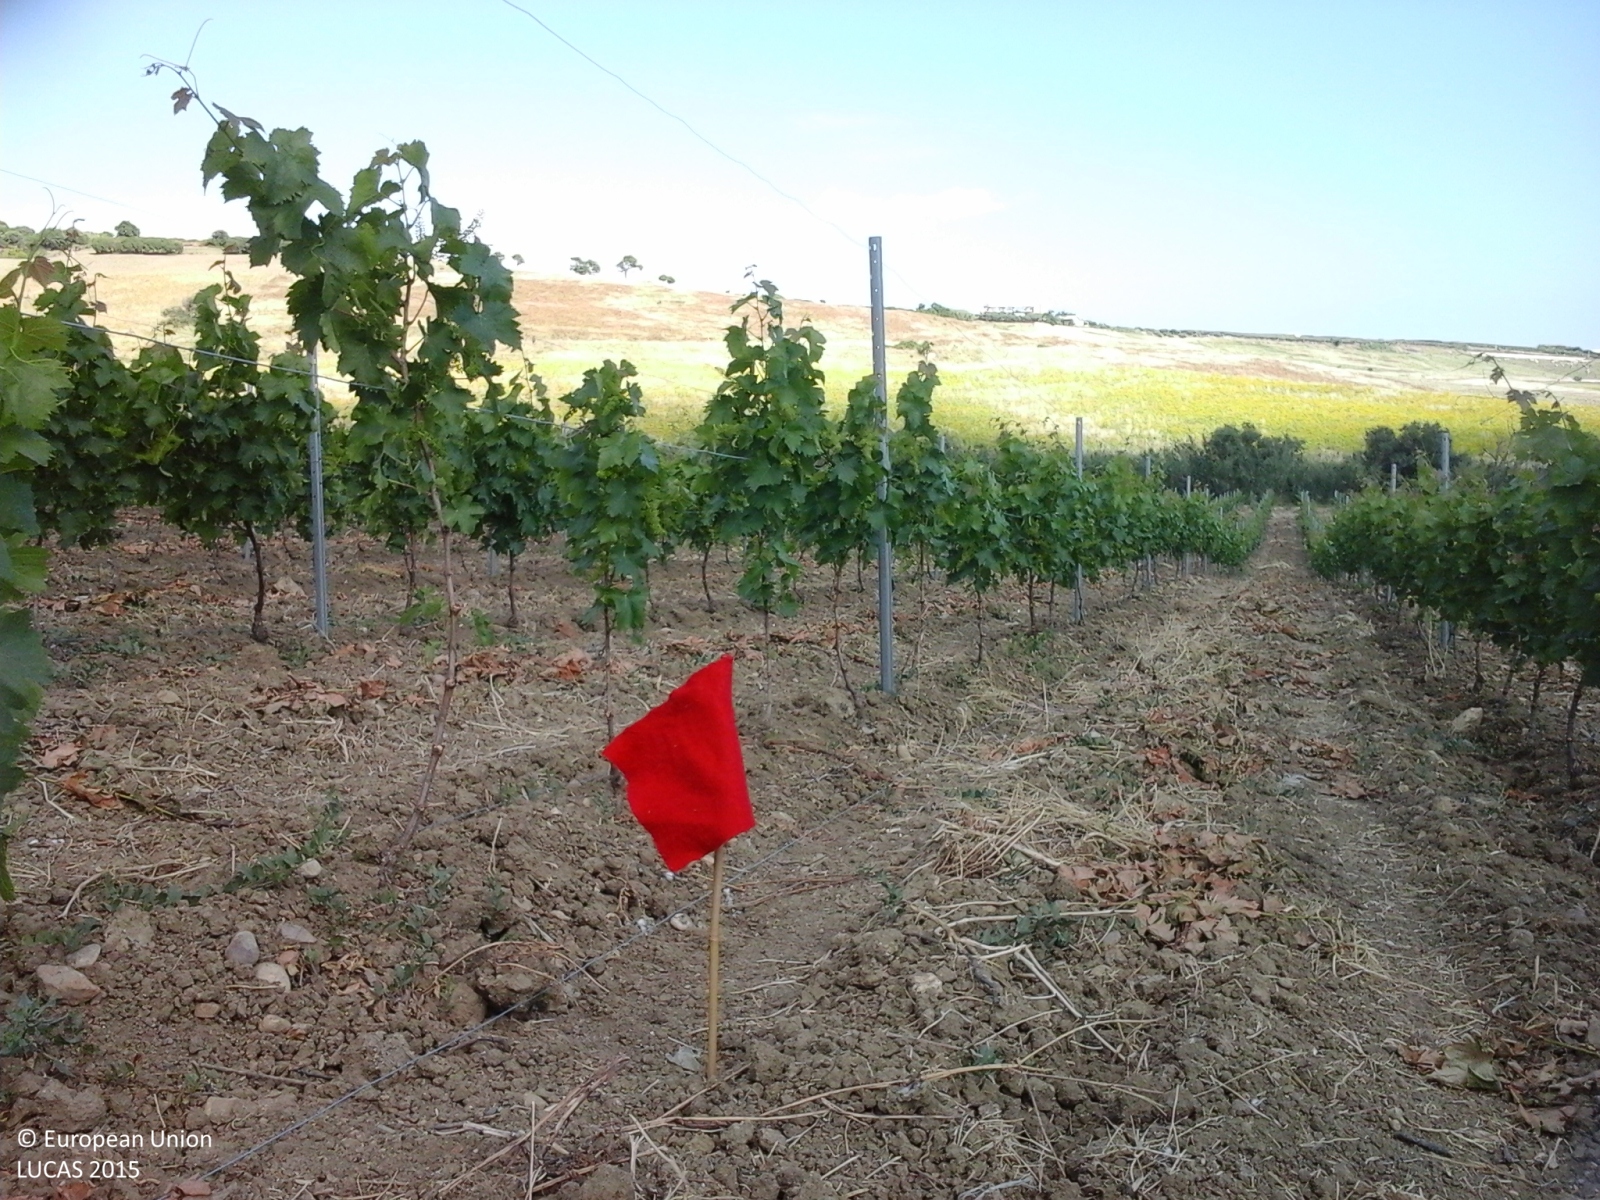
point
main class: Cropland
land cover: Vineyards
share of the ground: 10 - 25 %
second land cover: Other bare soil
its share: > 75 %
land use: Agriculture (excluding fallow land and kitchen gardens)
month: May
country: IT
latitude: 37.5919
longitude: 12.9785
